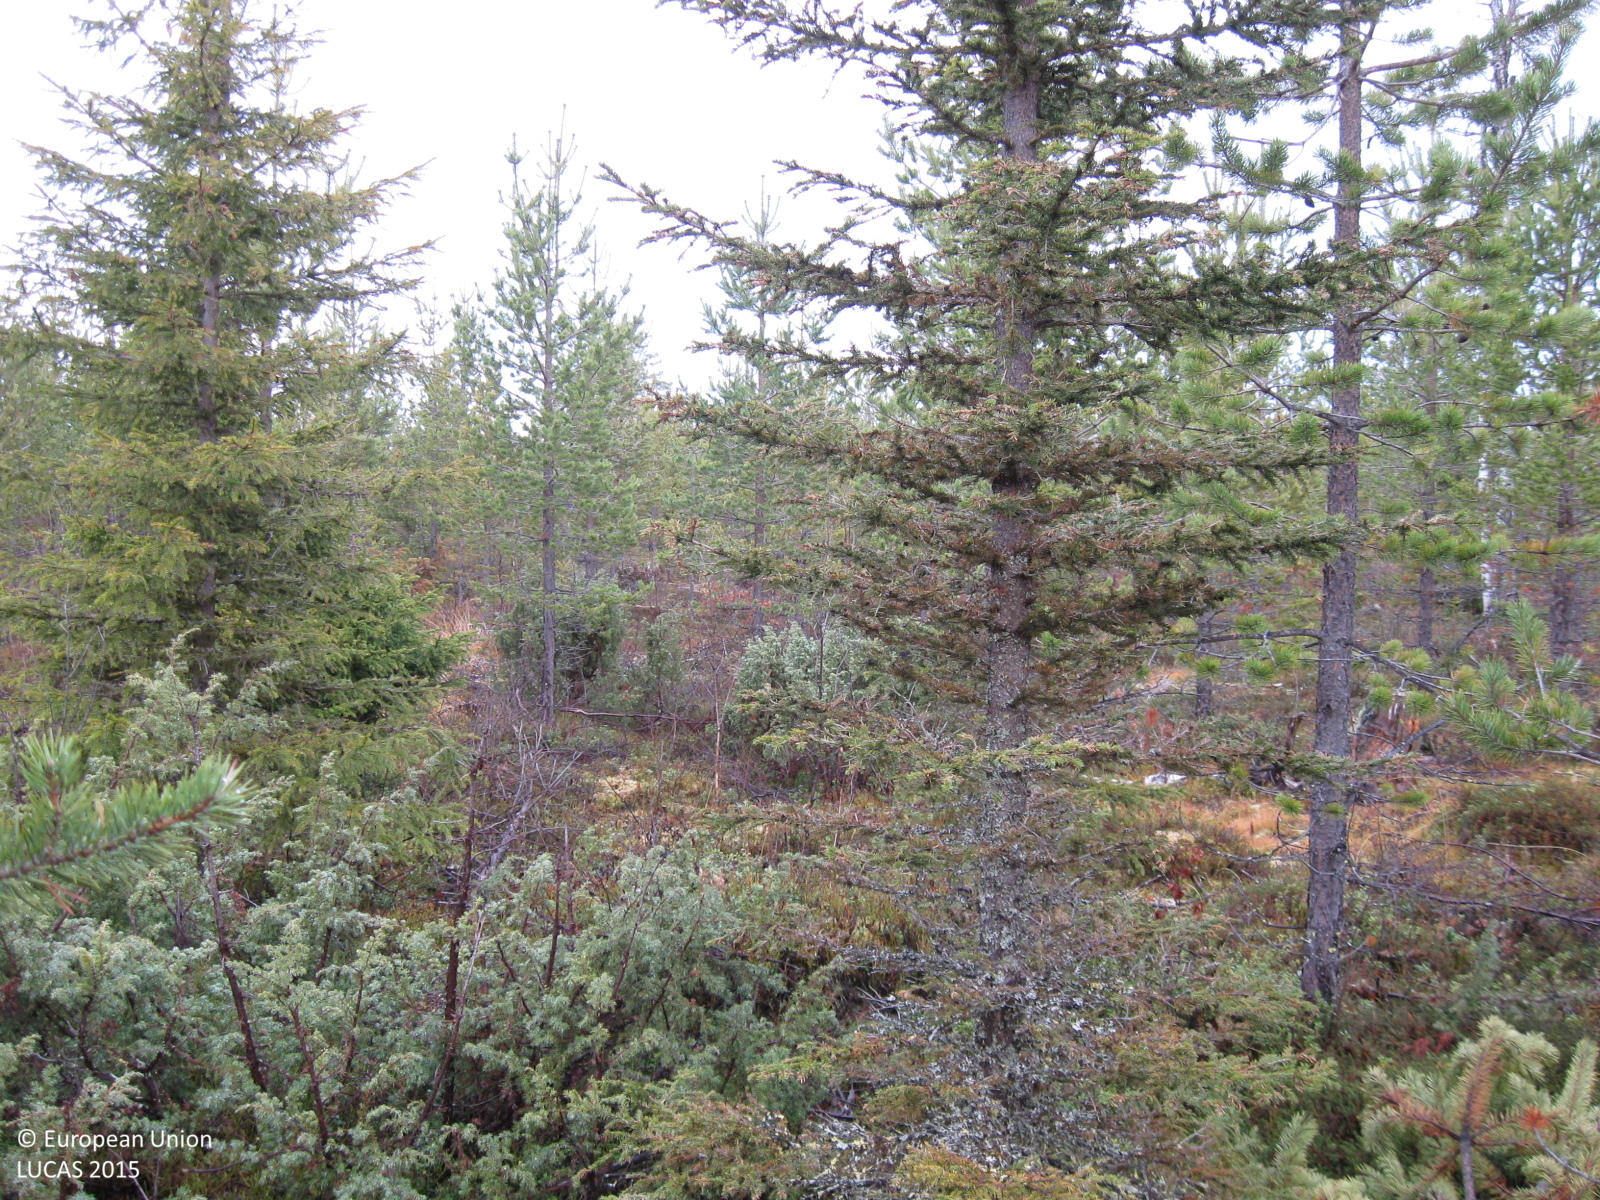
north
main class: Woodland
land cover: Pine dominated coniferous woodland
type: boreal forest
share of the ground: 50 - 75 %
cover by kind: coniferous forest trees 65 %, shrubs 15 %, lichens and mosses 10 %, broadleaved forest trees 5 %, herbaceous plants 5 %
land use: Forestry
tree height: < 5 m
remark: Nursery
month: October
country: SE
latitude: 66.4615
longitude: 21.6099
